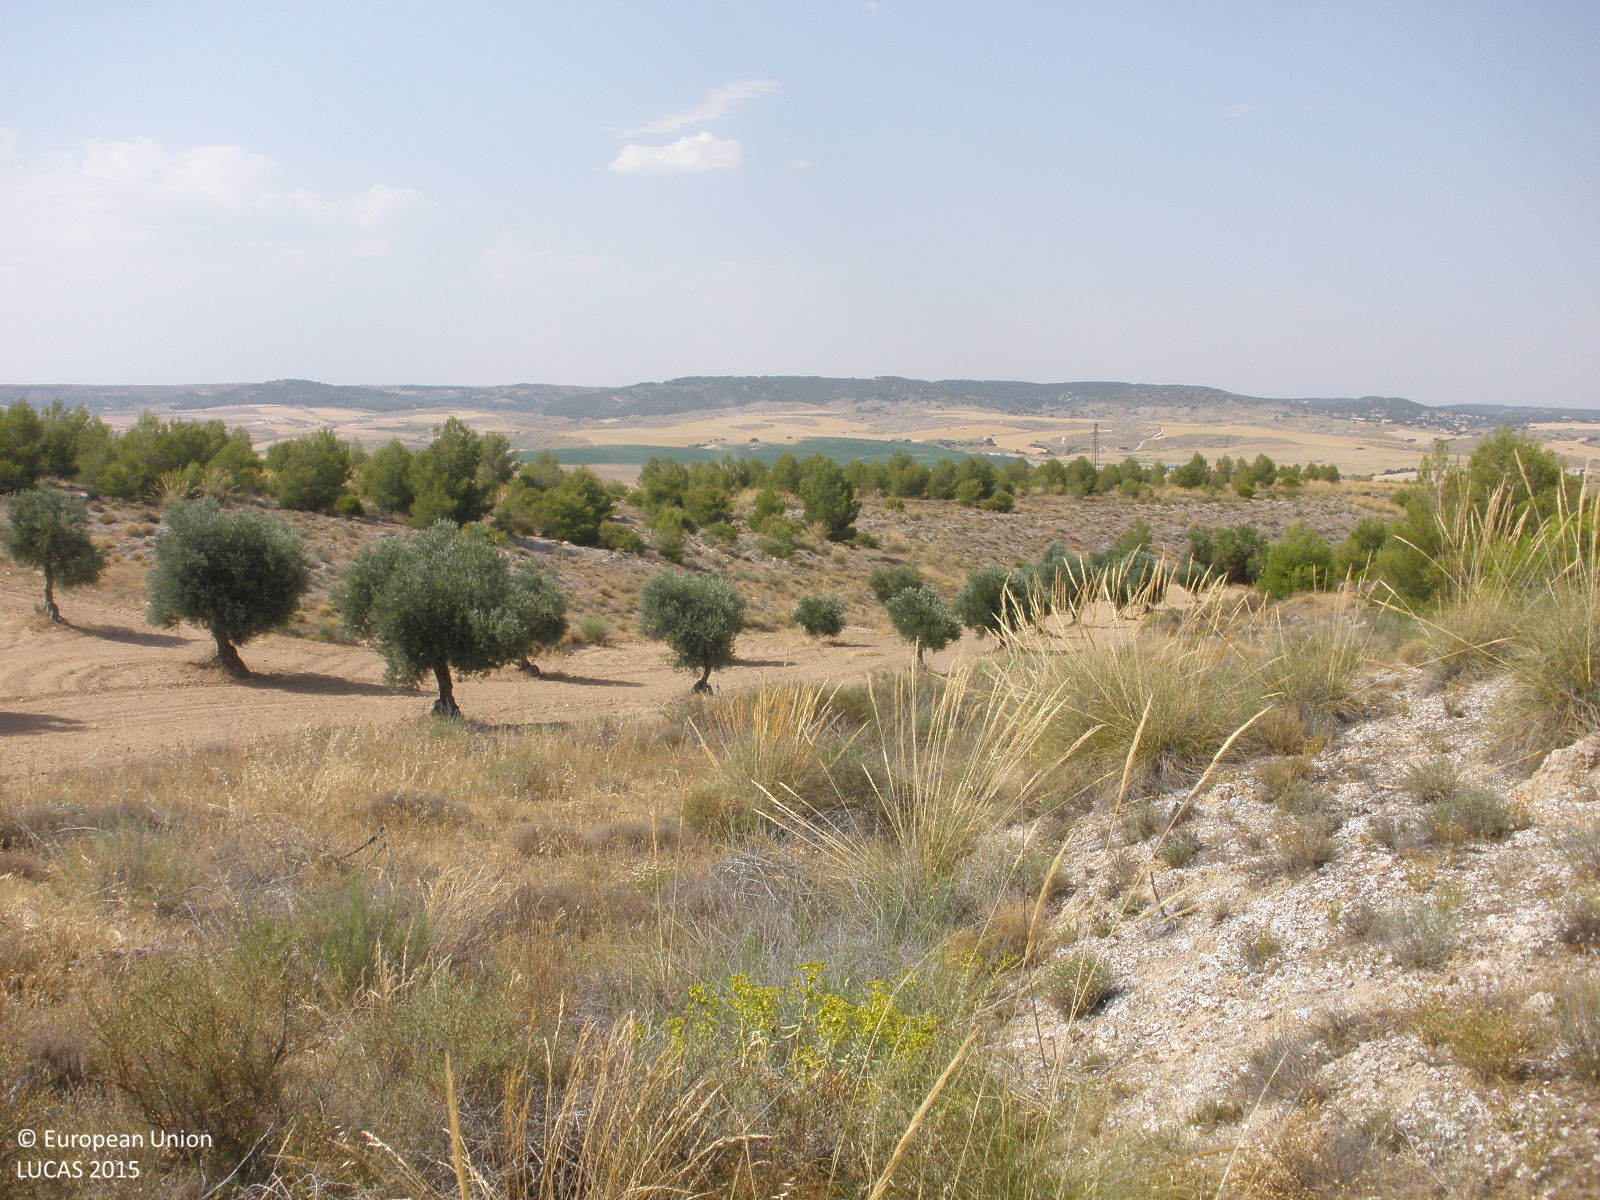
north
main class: Shrubland
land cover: Shrubland without tree cover
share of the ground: 25 - 50 %
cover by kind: herbaceous plants 50 %, shrubs 30 %, consolidated bare surface 20 %
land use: Semi-natural and natural areas not in use
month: July
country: ES
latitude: 40.0278
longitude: -3.3514
